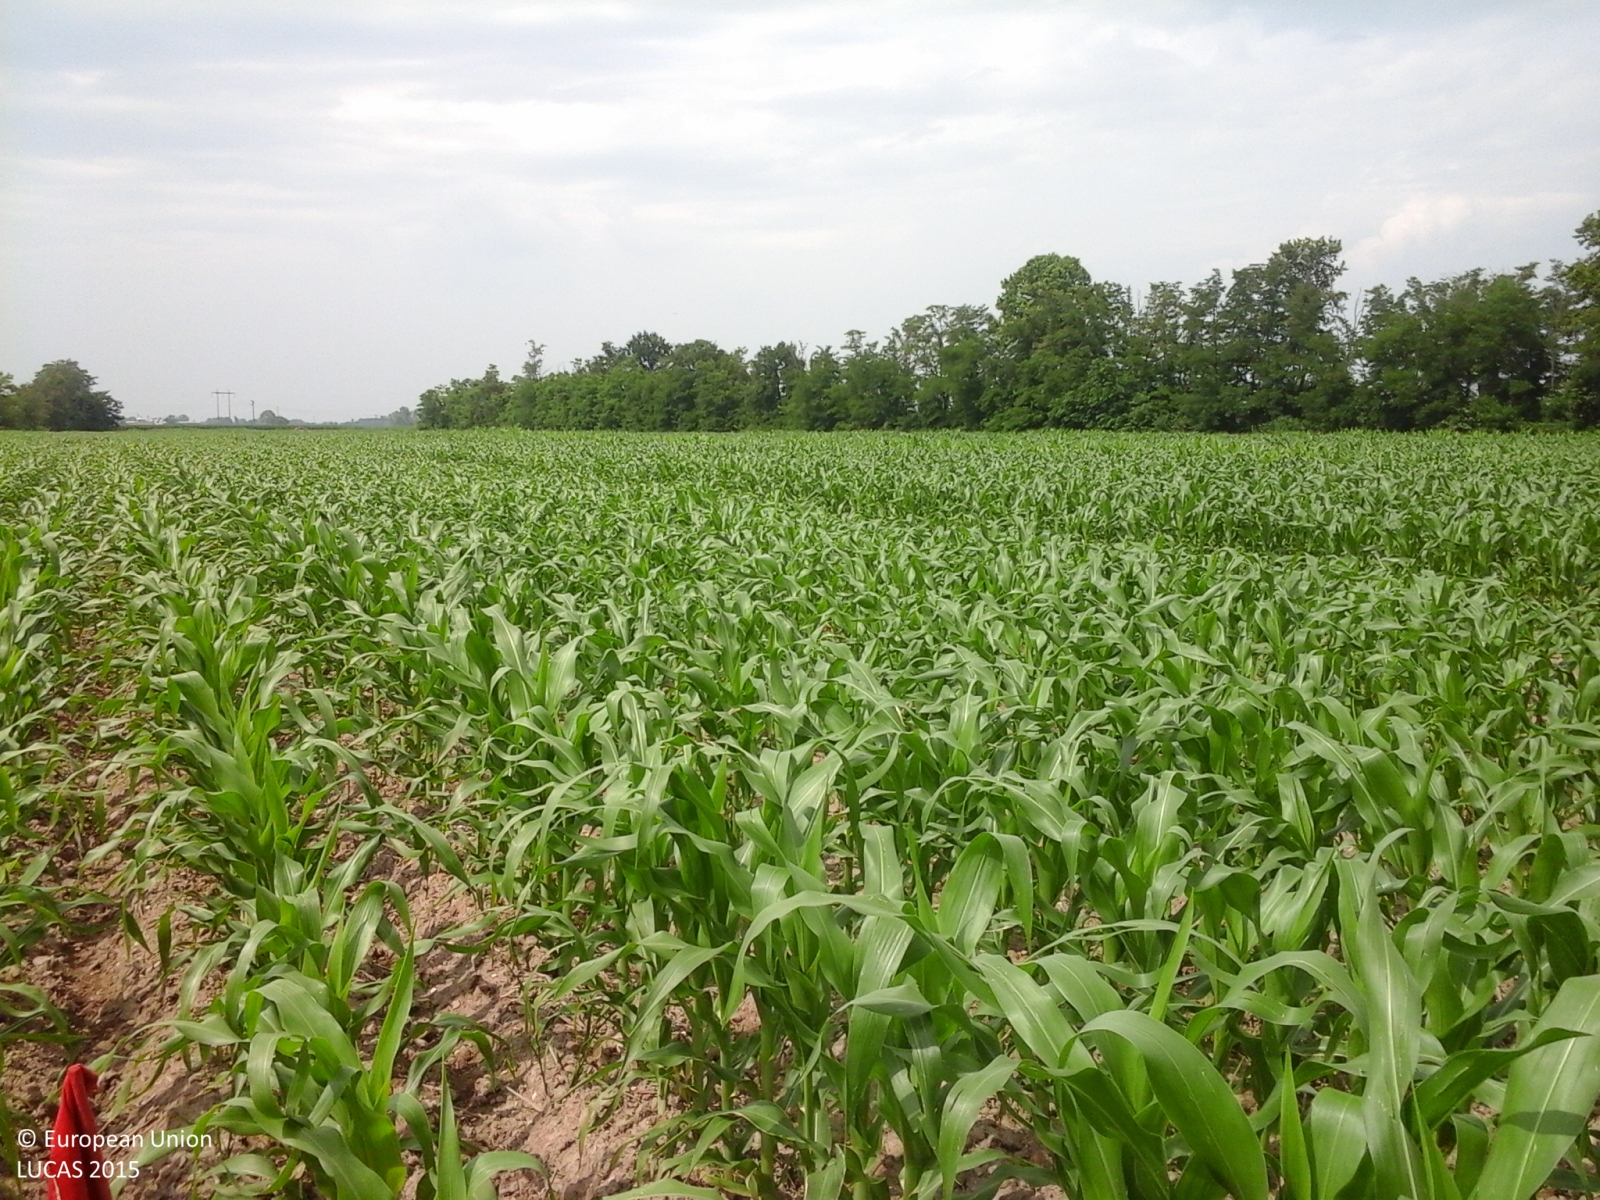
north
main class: Cropland
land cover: Maize
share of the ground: 50 - 75 %
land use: Agriculture (excluding fallow land and kitchen gardens)
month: June
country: IT
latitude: 45.3884
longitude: 8.7122
